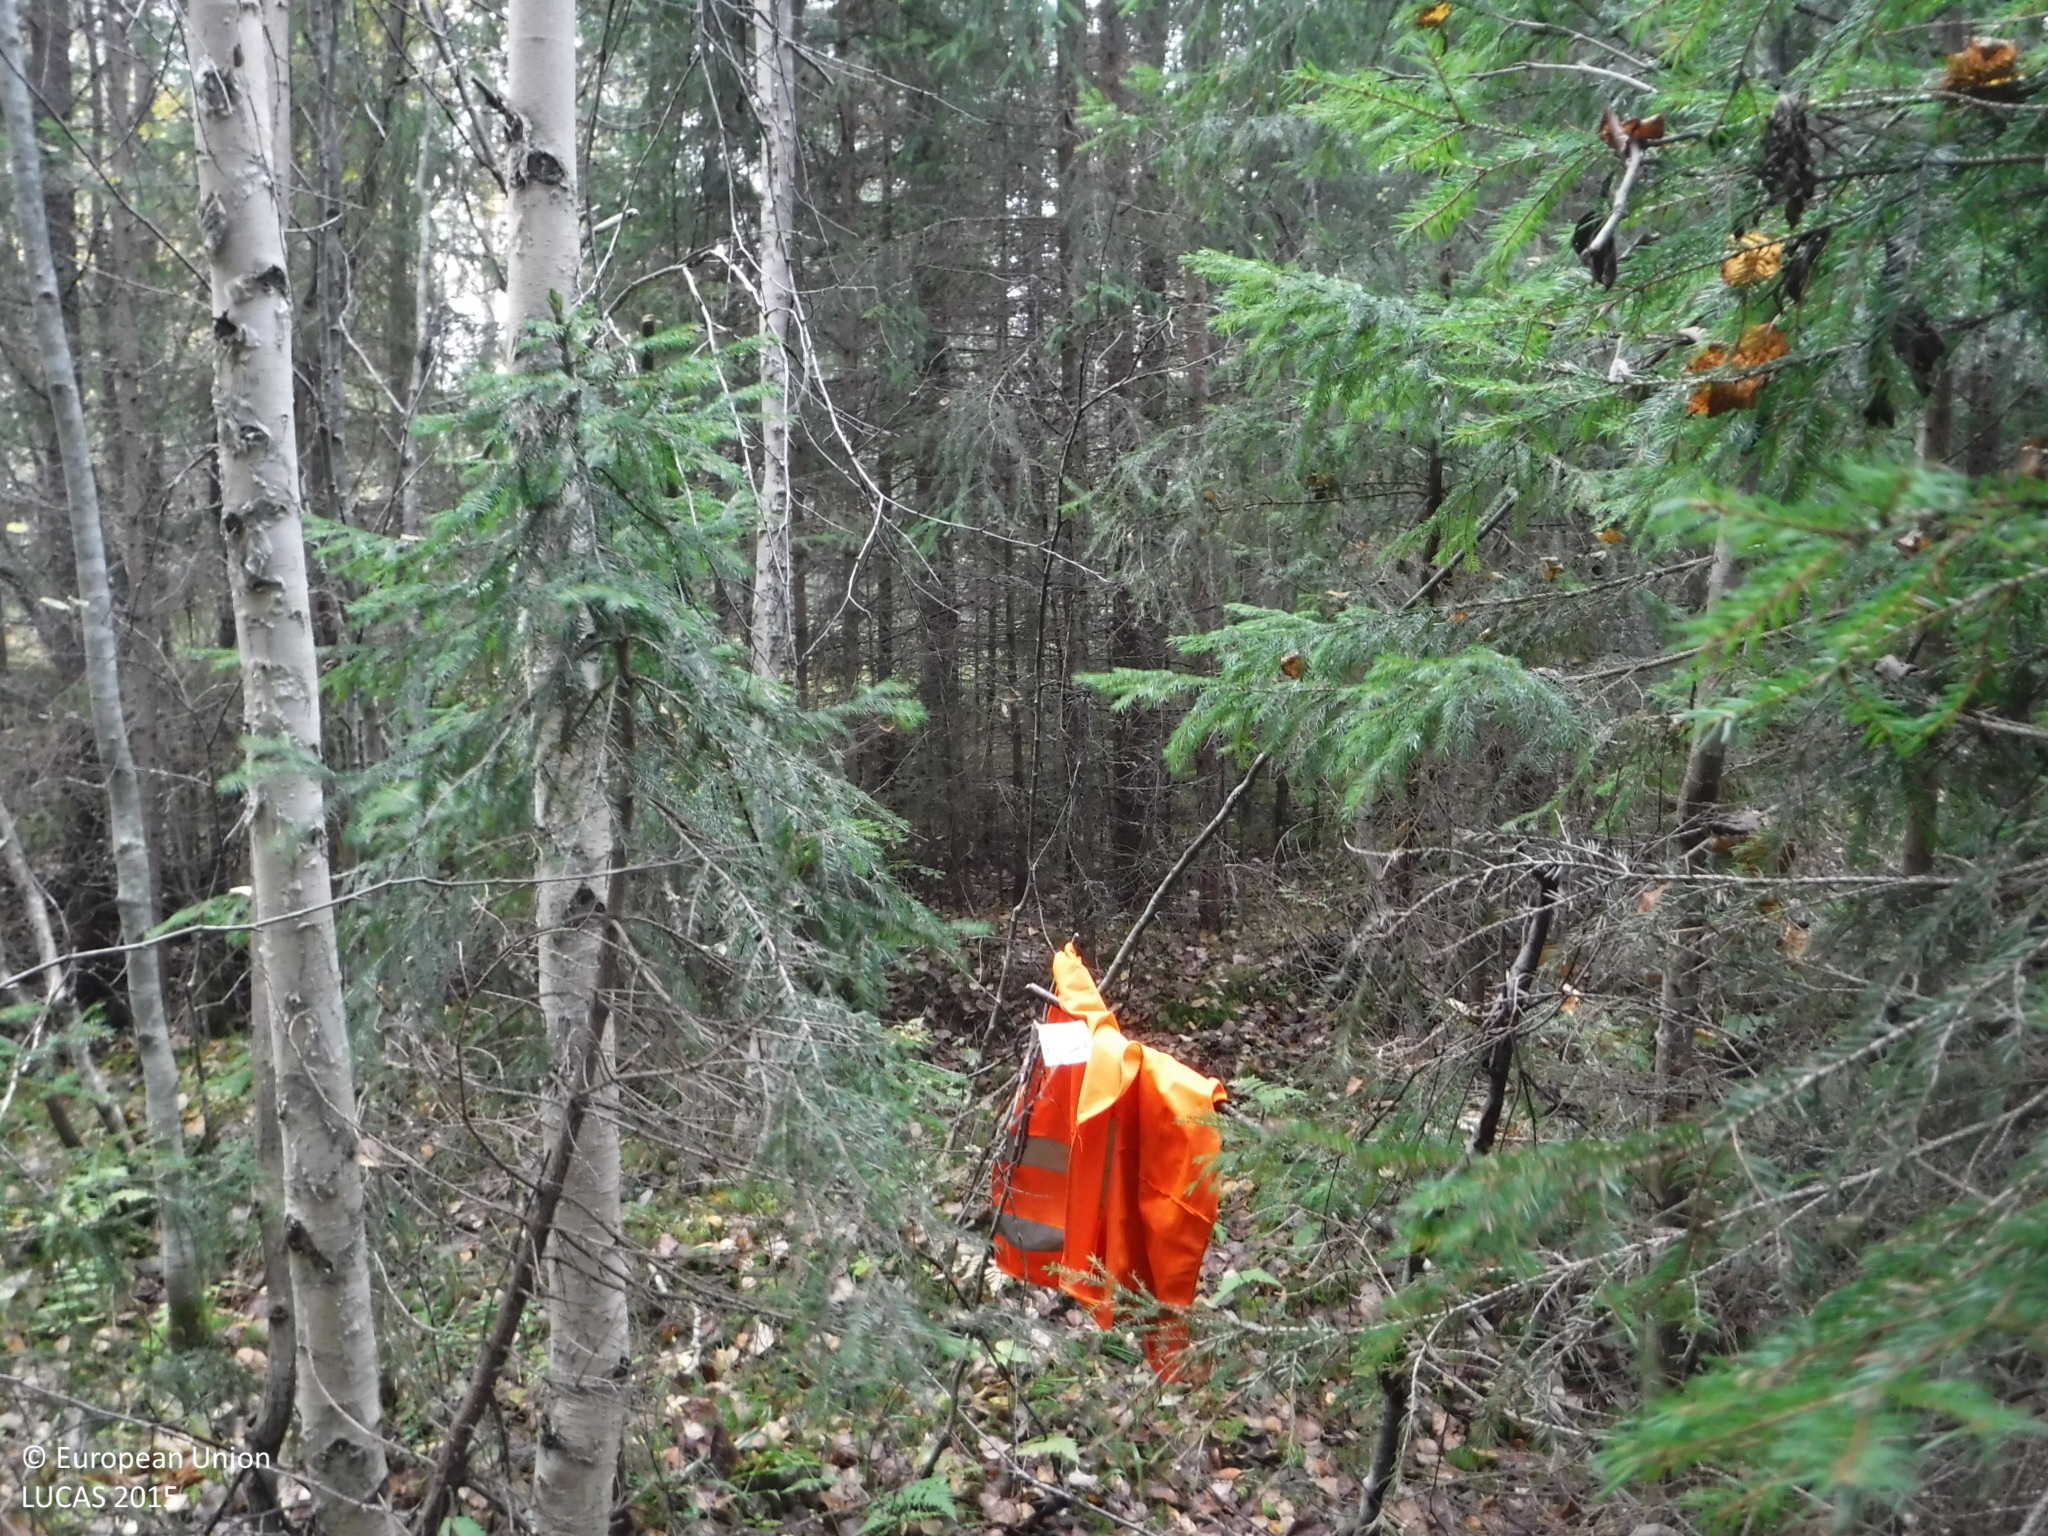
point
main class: Woodland
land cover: Spruce dominated mixed woodland
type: boreal forest
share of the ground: > 75 %
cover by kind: coniferous forest trees 40 %, broadleaved forest trees 40 %, lichens and mosses 15 %, shrubs 5 %
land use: Forestry
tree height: > 5 m
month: September
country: FI
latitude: 61.5470
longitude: 24.0307
